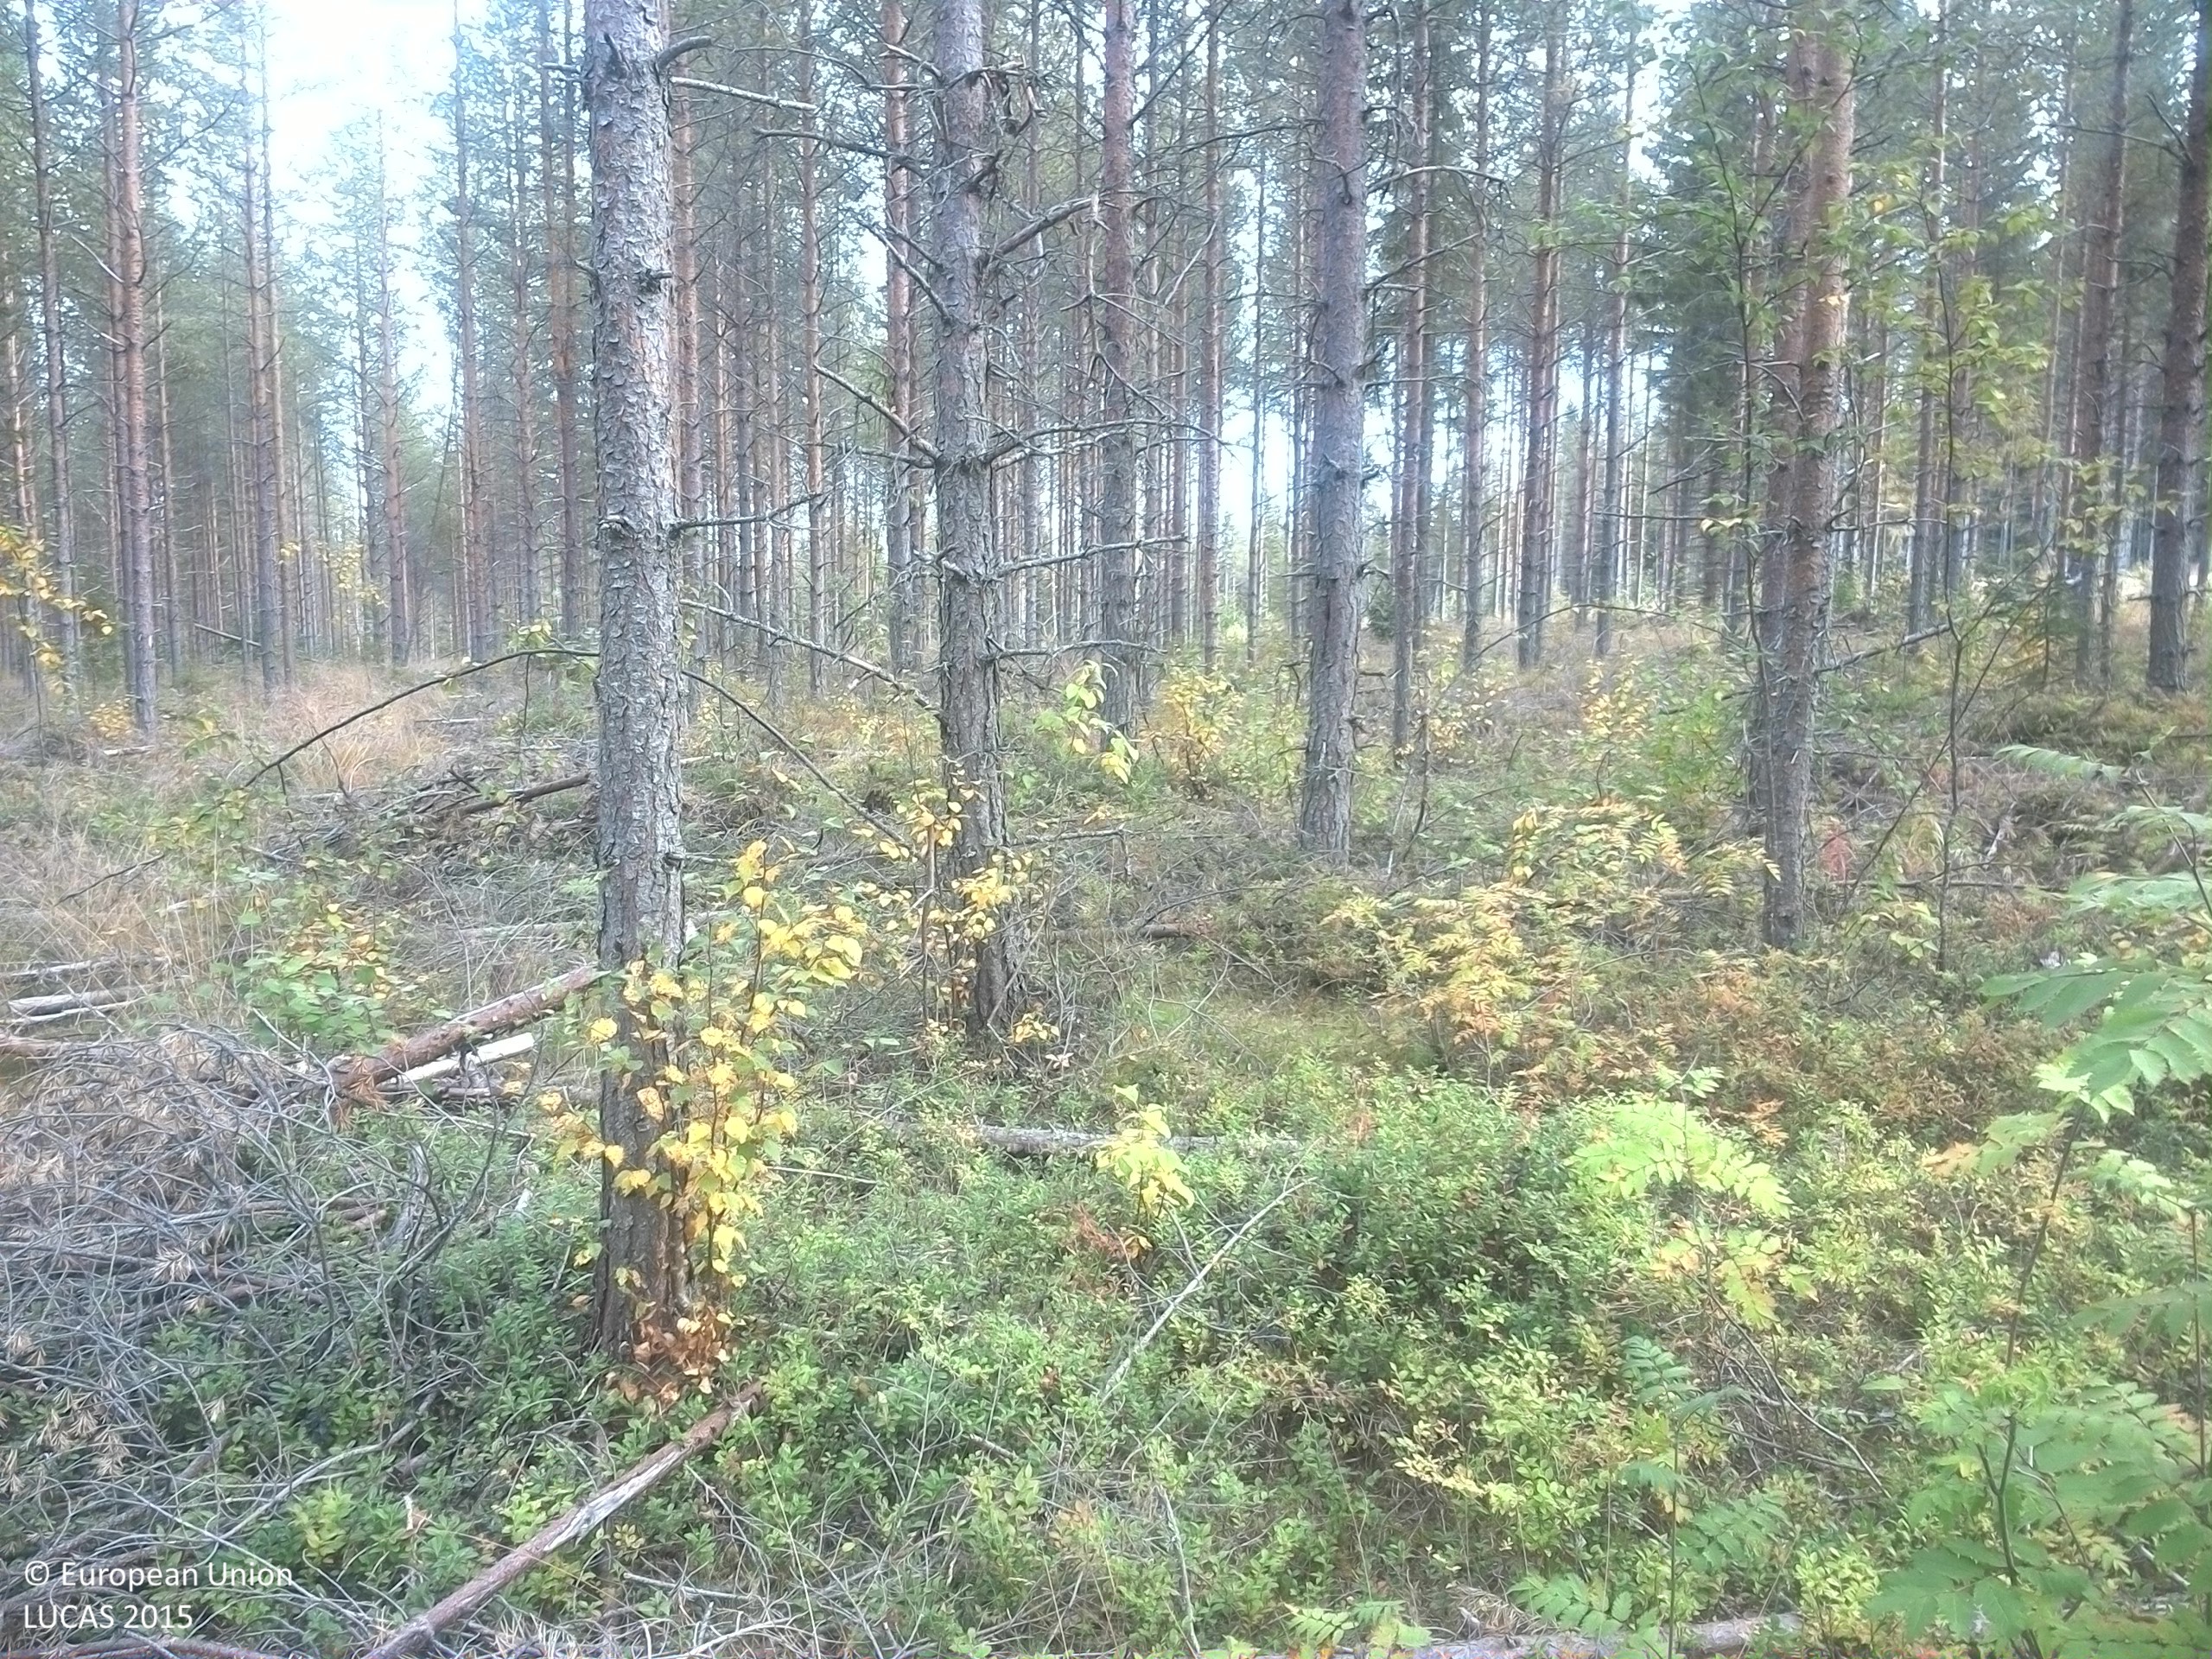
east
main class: Woodland
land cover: Pine dominated coniferous woodland
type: boreal forest
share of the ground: 50 - 75 %
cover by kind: coniferous forest trees 45 %, shrubs 35 %, lichens and mosses 10 %, broadleaved forest trees 5 %, herbaceous plants 5 %
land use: Forestry
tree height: > 5 m
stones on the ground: < 10 %
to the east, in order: Pine dominated coniferous woodland; Broadleaved woodland; Ditches and canals; Paved roads, cycling and walking lanes; Ditches and canals; Shrubland with sparse tree cover; Spruce dominated coniferous woodland
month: September
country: SE
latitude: 63.8336
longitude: 16.4150
